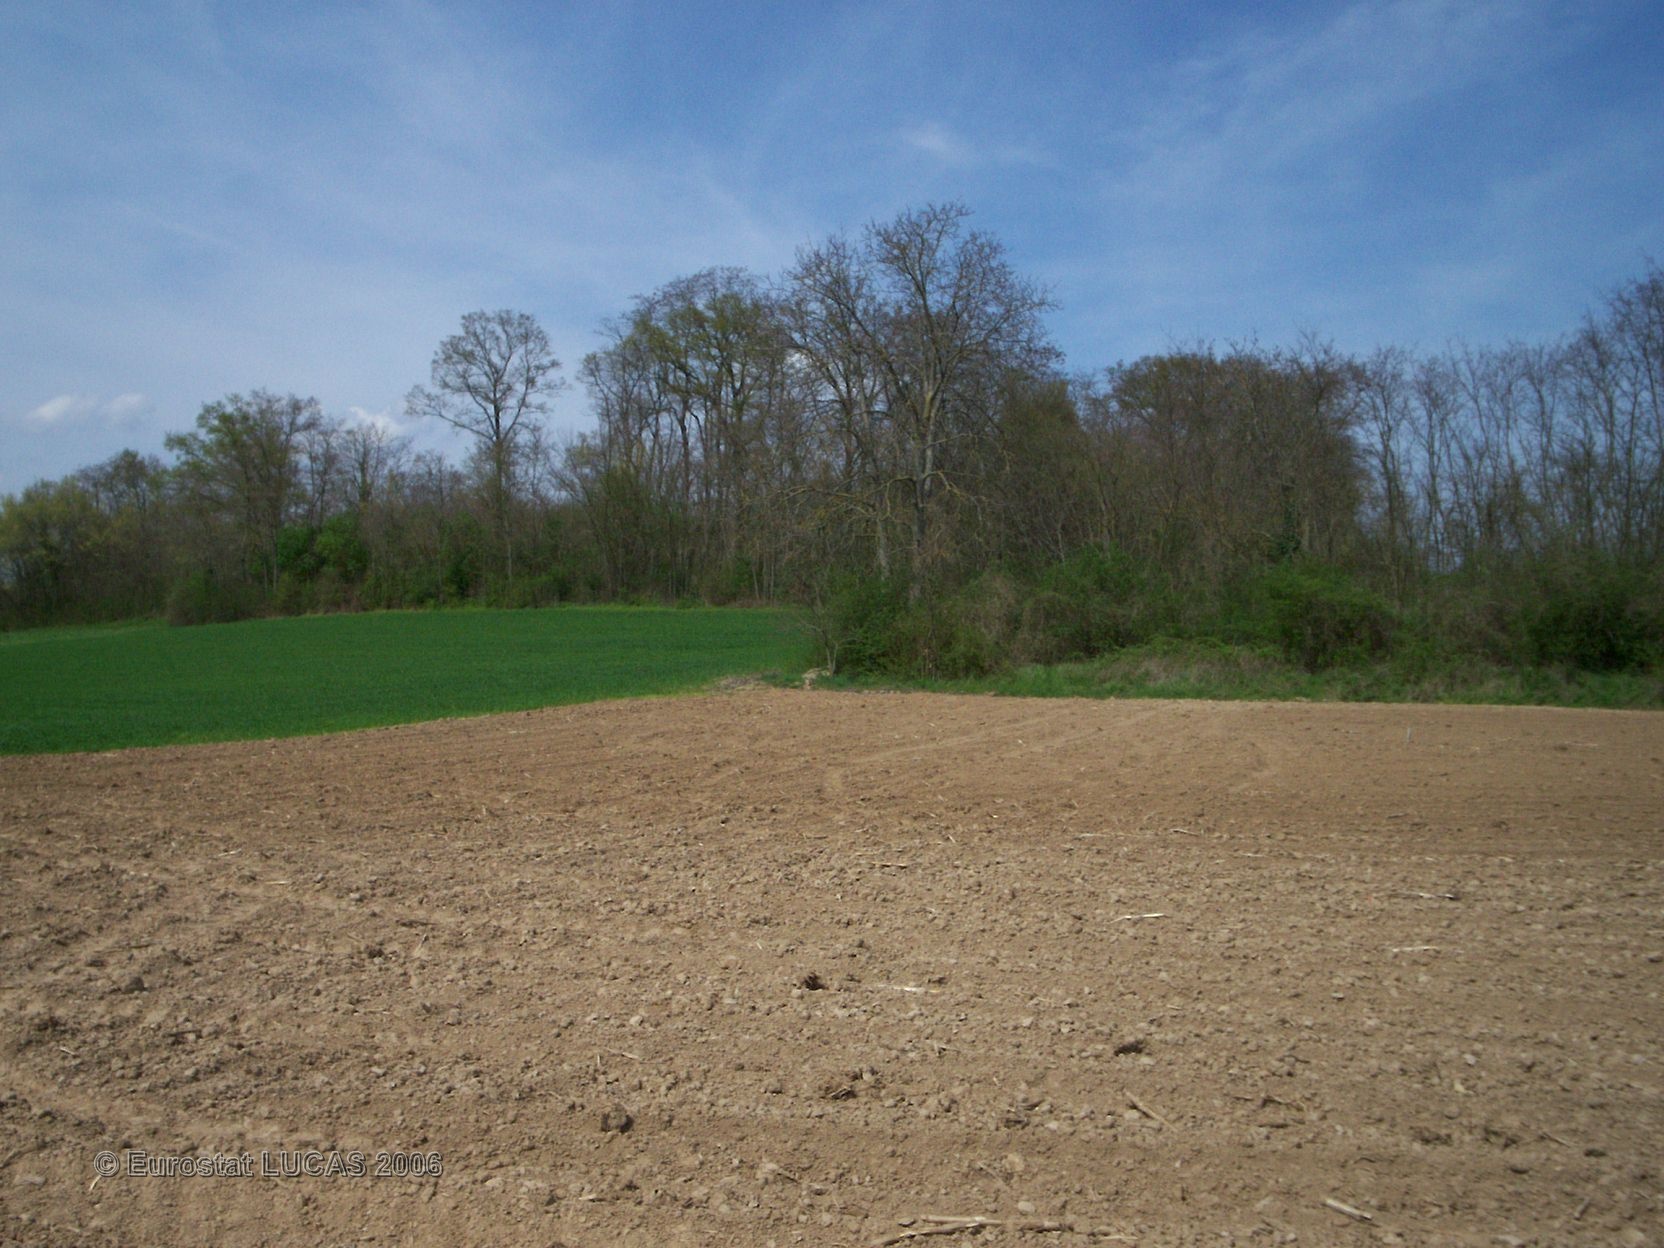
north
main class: Cropland
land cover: Sugar beet
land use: Agriculture (excluding fallow land and kitchen gardens)
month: April
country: FR
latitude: 48.3400
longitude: 2.9359
